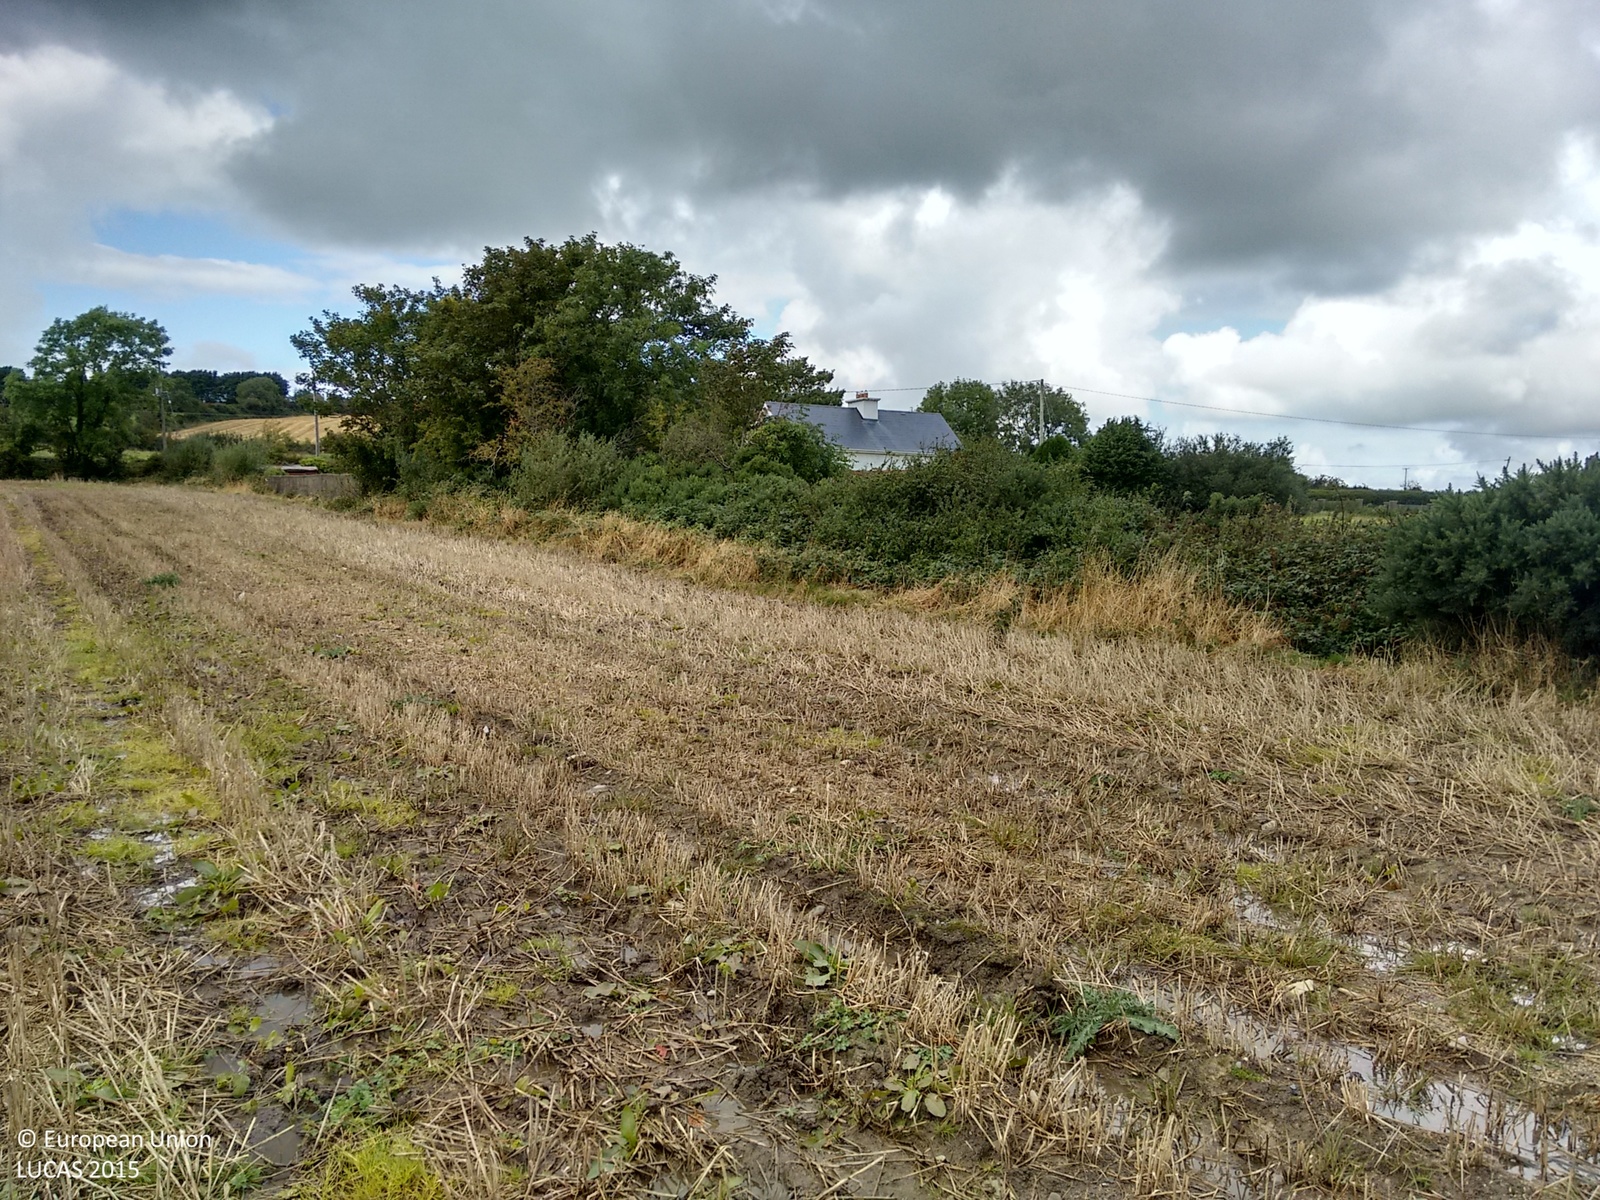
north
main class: Cropland
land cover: Common wheat
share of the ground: 25 - 50 %
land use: Agriculture (excluding fallow land and kitchen gardens)
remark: Harvested field
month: September
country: IE
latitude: 52.4306
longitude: -9.4540
